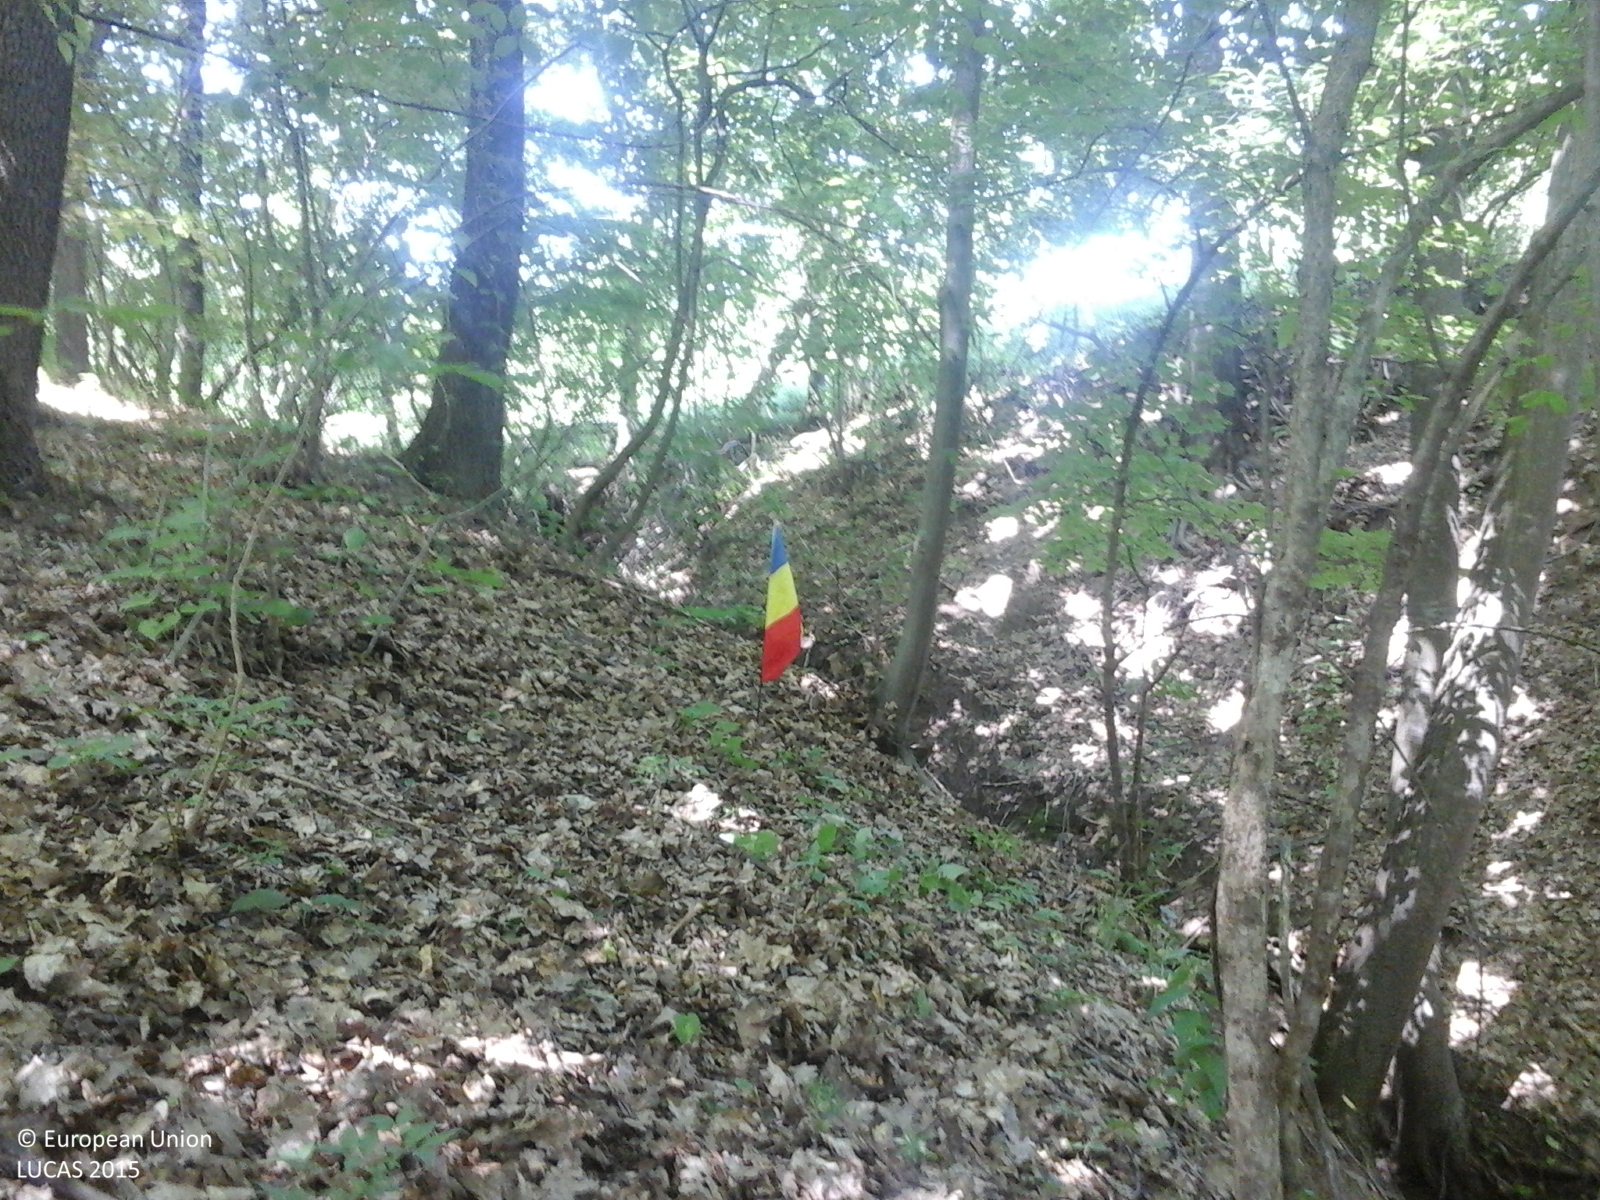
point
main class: Woodland
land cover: Broadleaved woodland
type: beech forest
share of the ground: > 75 %
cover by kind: broadleaved forest trees 100 %
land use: Forestry
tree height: > 5 m
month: June
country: RO
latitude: 45.1286
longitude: 26.1718
